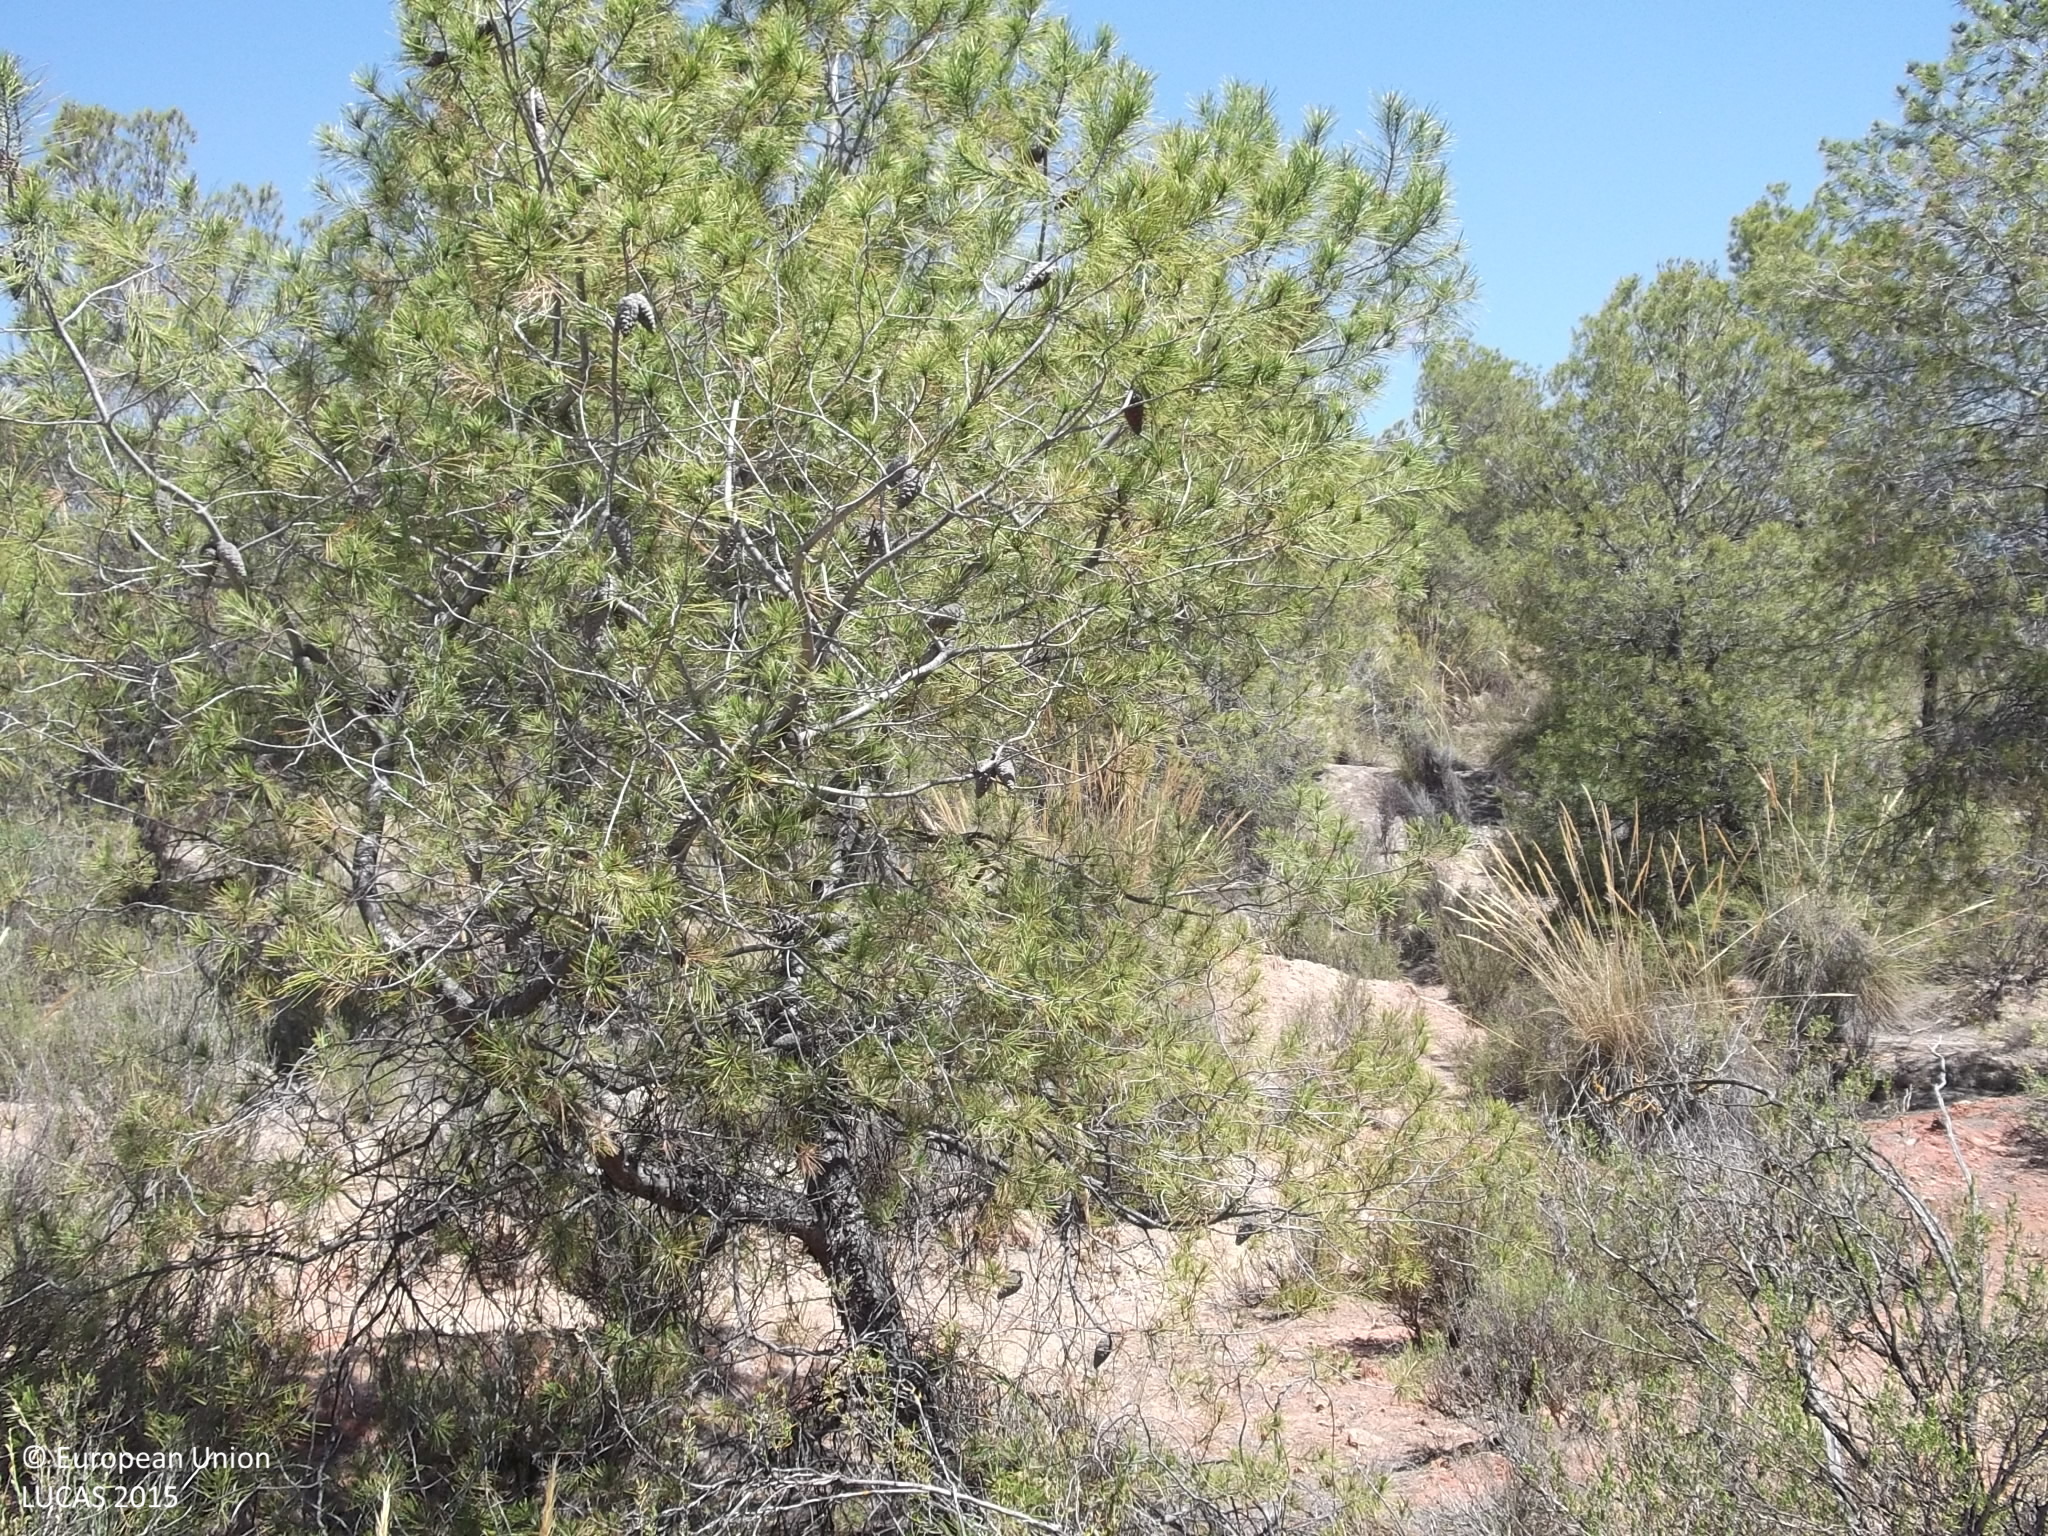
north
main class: Woodland
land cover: Pine dominated coniferous woodland
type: coniferous forest of the mediterranean region
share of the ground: 25 - 50 %
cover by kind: coniferous forest trees 30 %, shrubs 30 %, herbaceous plants 20 %, consolidated bare surface 20 %
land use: Semi-natural and natural areas not in use
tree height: > 5 m
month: June
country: ES
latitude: 38.1933
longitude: -1.5550
